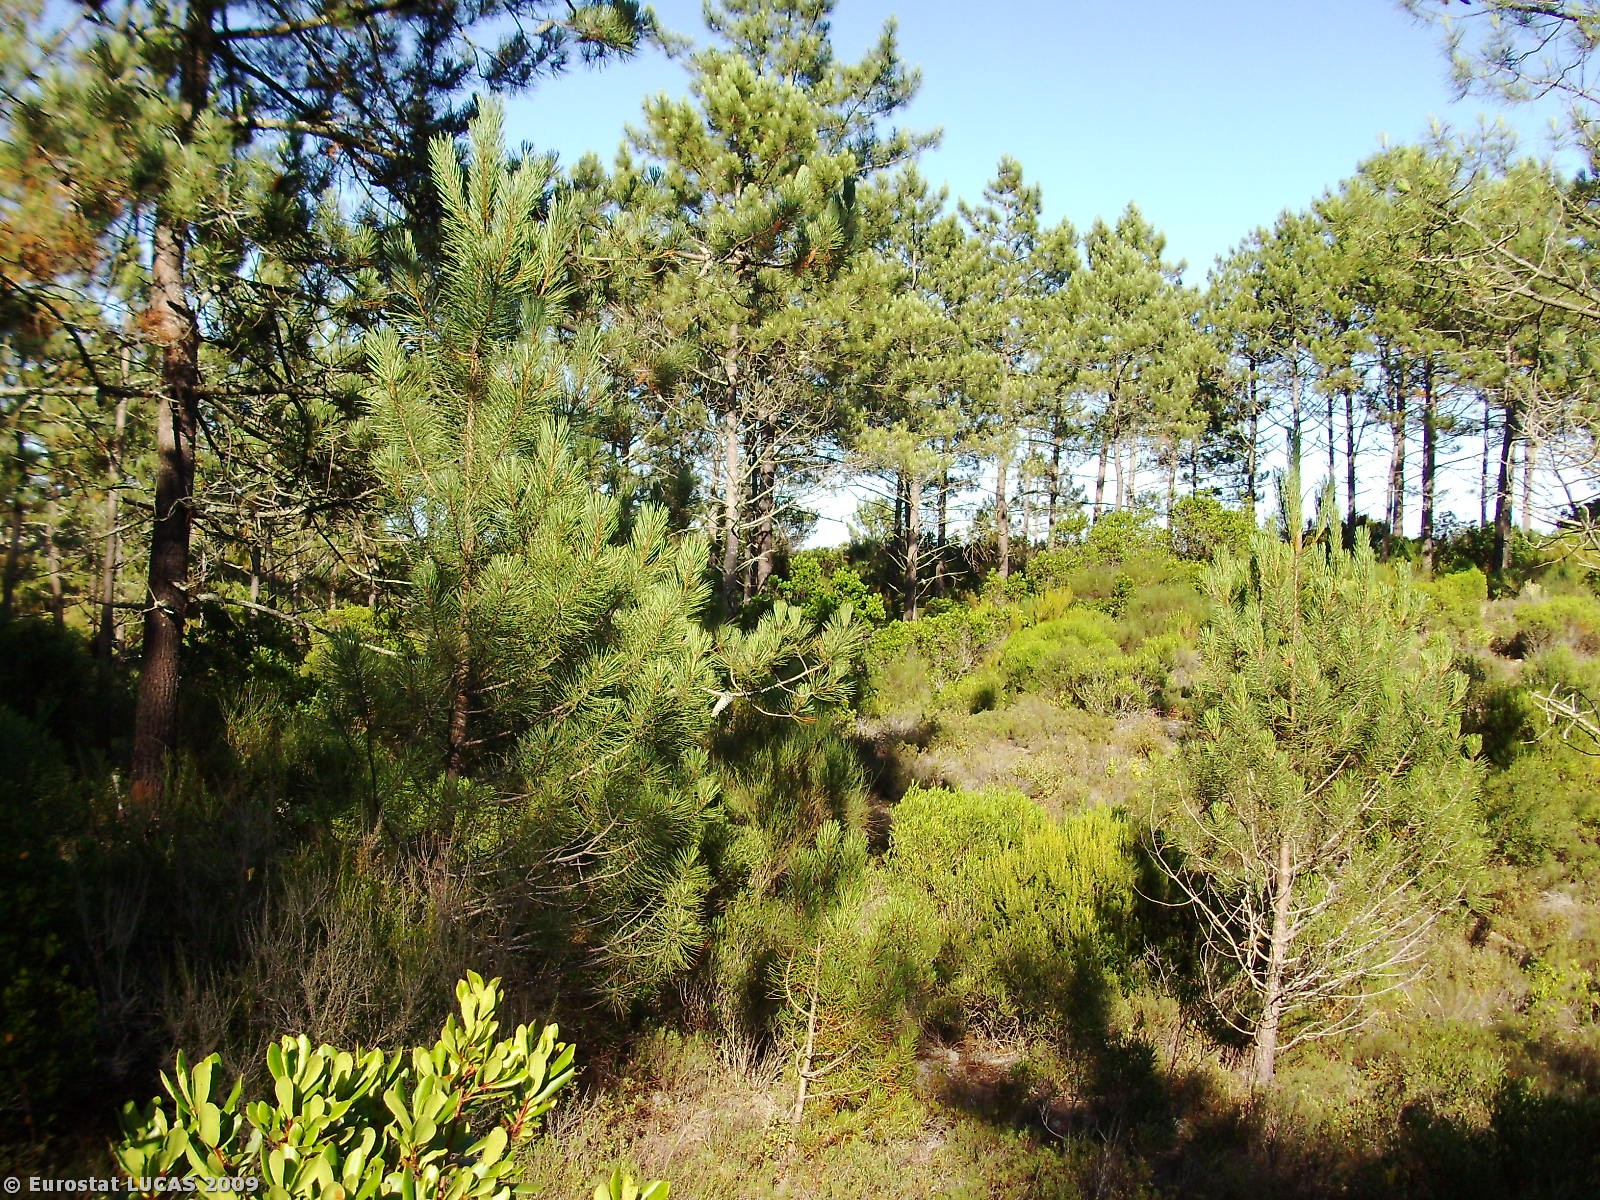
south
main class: Woodland
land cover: Coniferous woodland
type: coniferous forest of the mediterranean region
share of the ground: 50 - 75 %
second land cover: Grassland with sparse tree/shrub cover
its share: 25 - 50 %
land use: Forestry
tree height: > 5 m
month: July
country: PT
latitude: 39.8033
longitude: -8.9783
